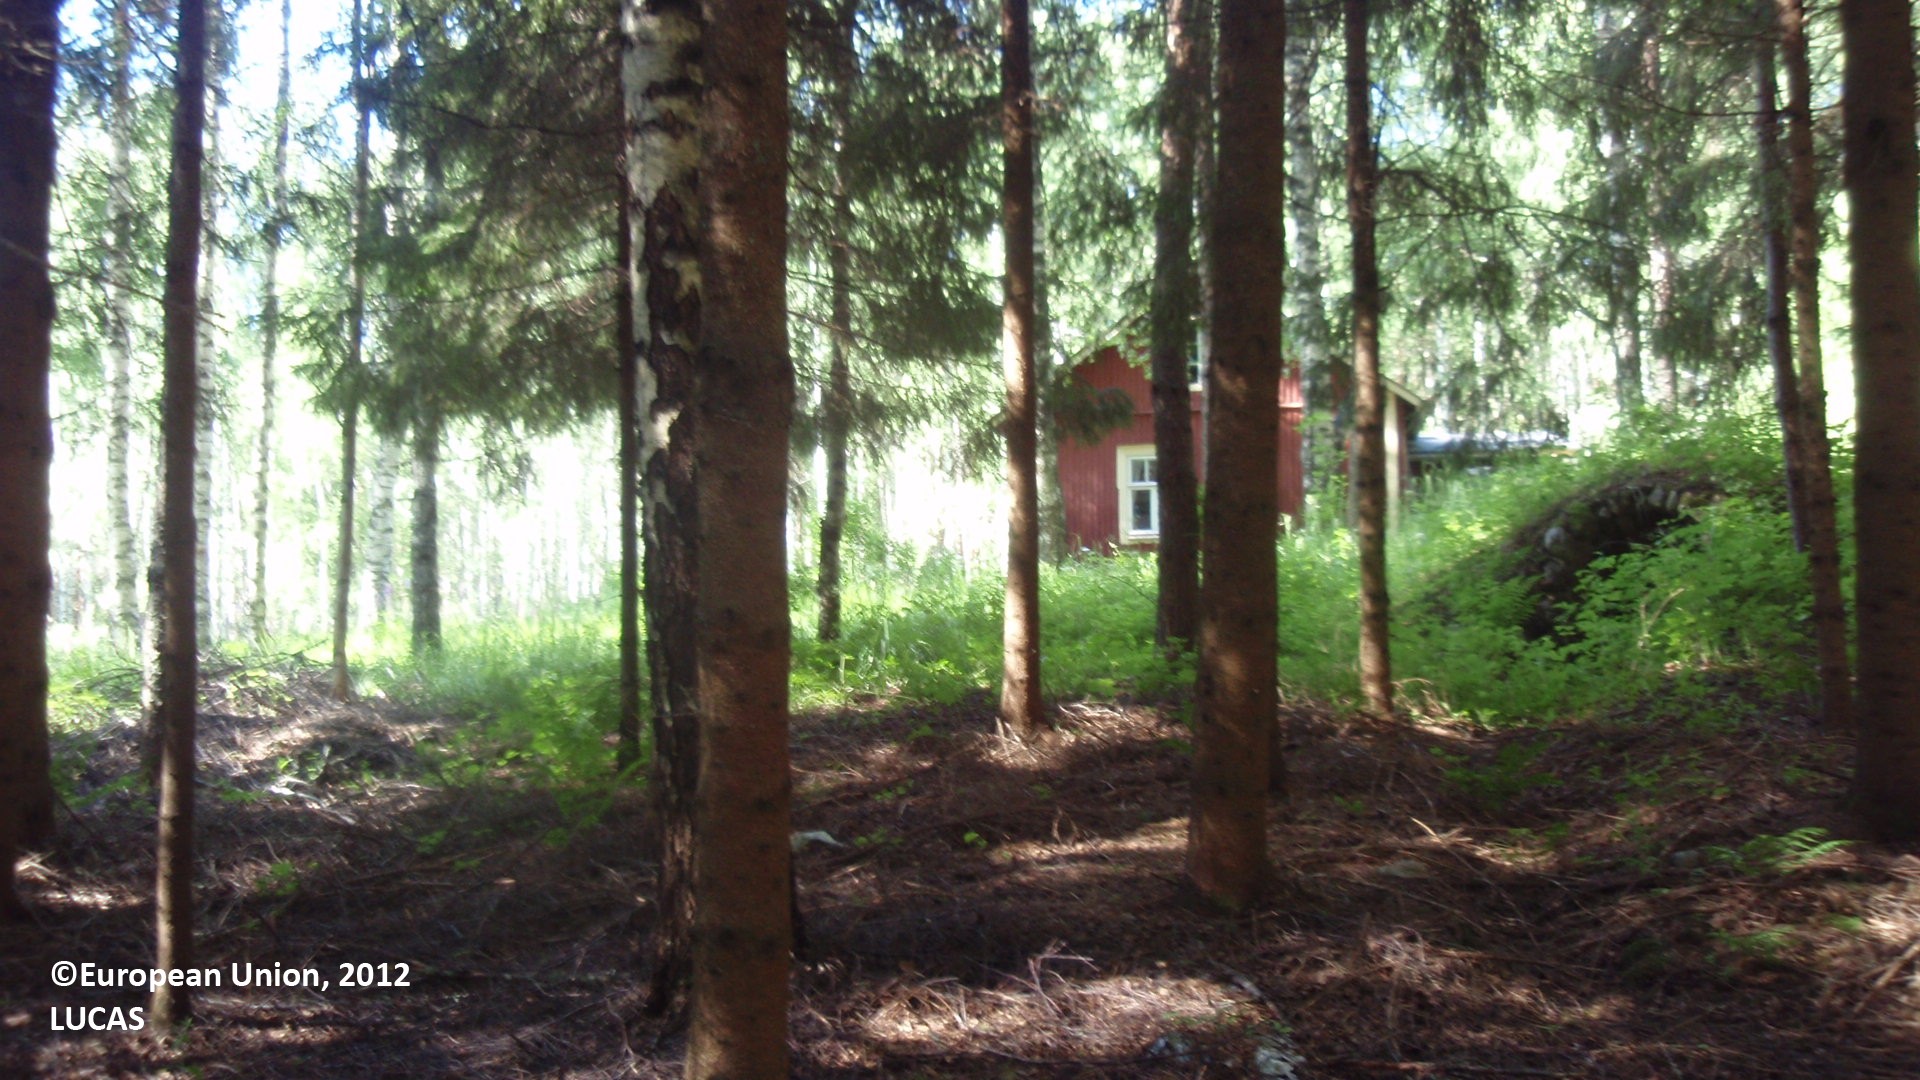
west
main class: Woodland
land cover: Spruce dominated mixed woodland
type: boreal forest
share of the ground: 25 - 50 %
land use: Forestry
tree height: > 5 m
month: July
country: FI
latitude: 61.7120
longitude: 28.1872
